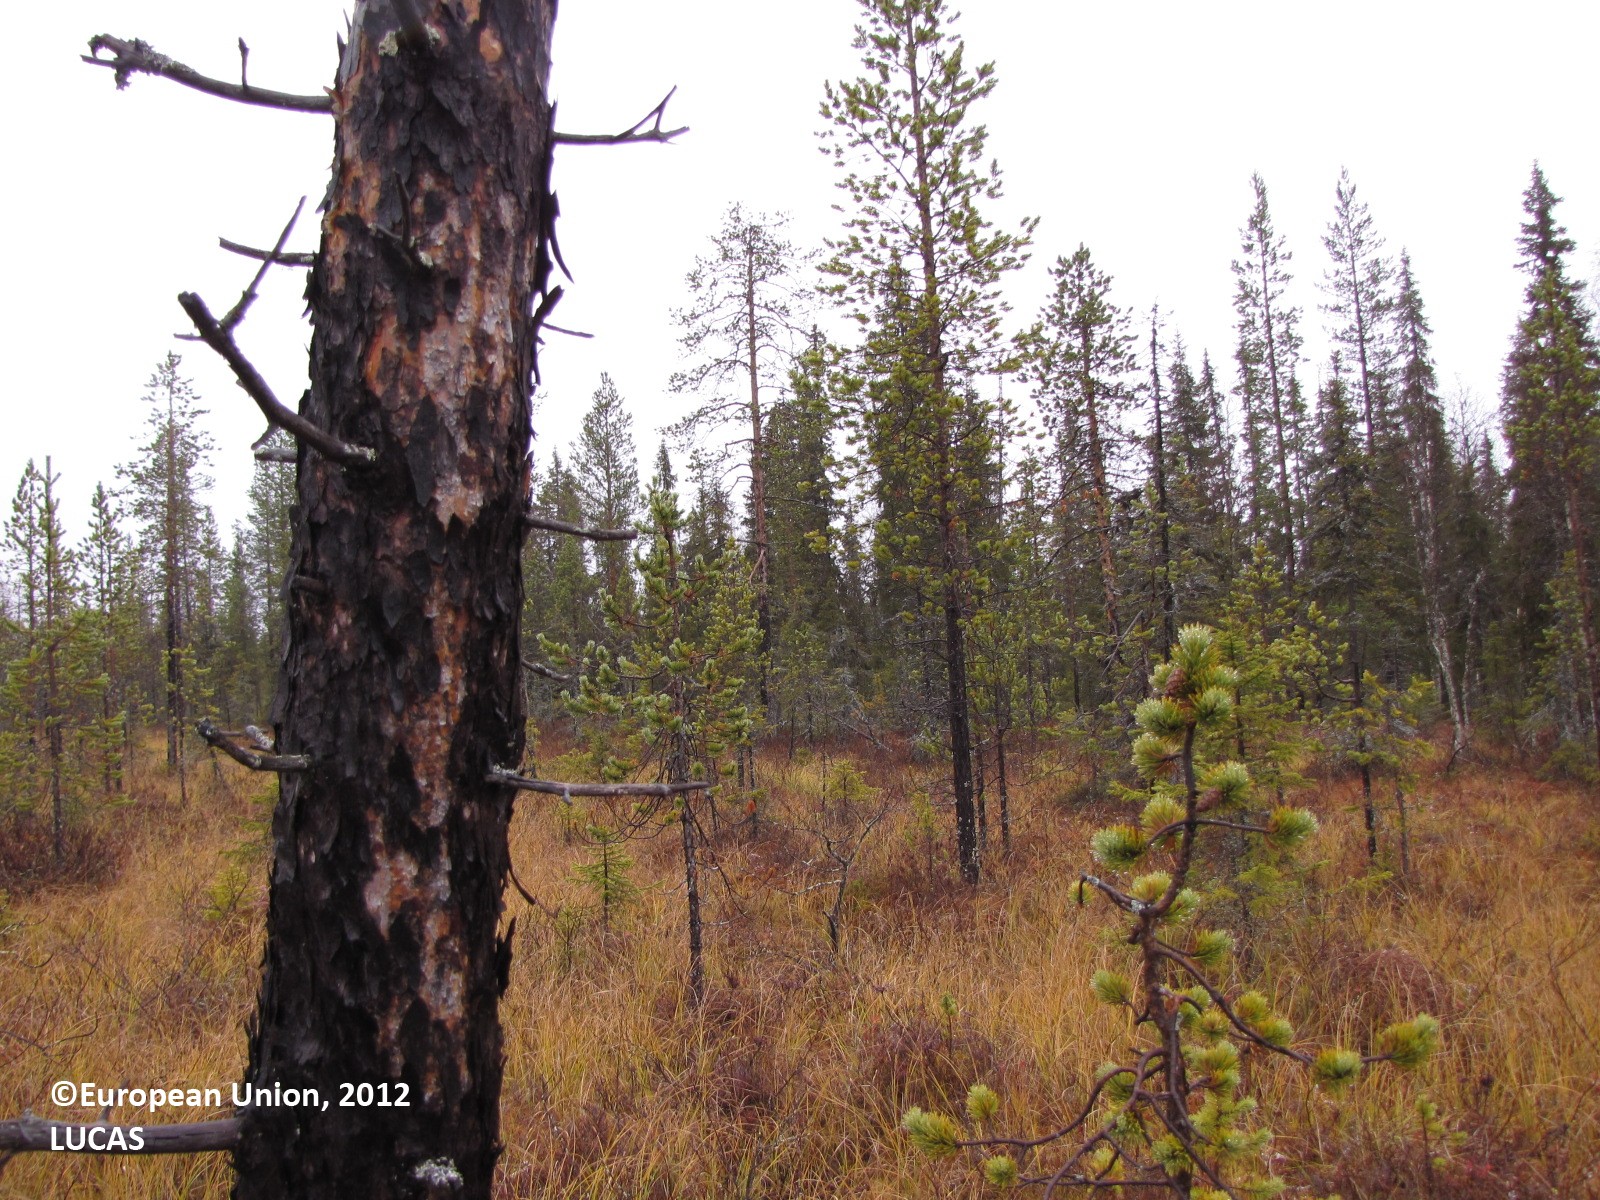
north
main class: Woodland
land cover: Pine dominated coniferous woodland
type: boreal forest
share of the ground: 10 - 25 %
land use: Forestry
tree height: < 5 m
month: September
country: FI
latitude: 67.7147
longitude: 23.6017
